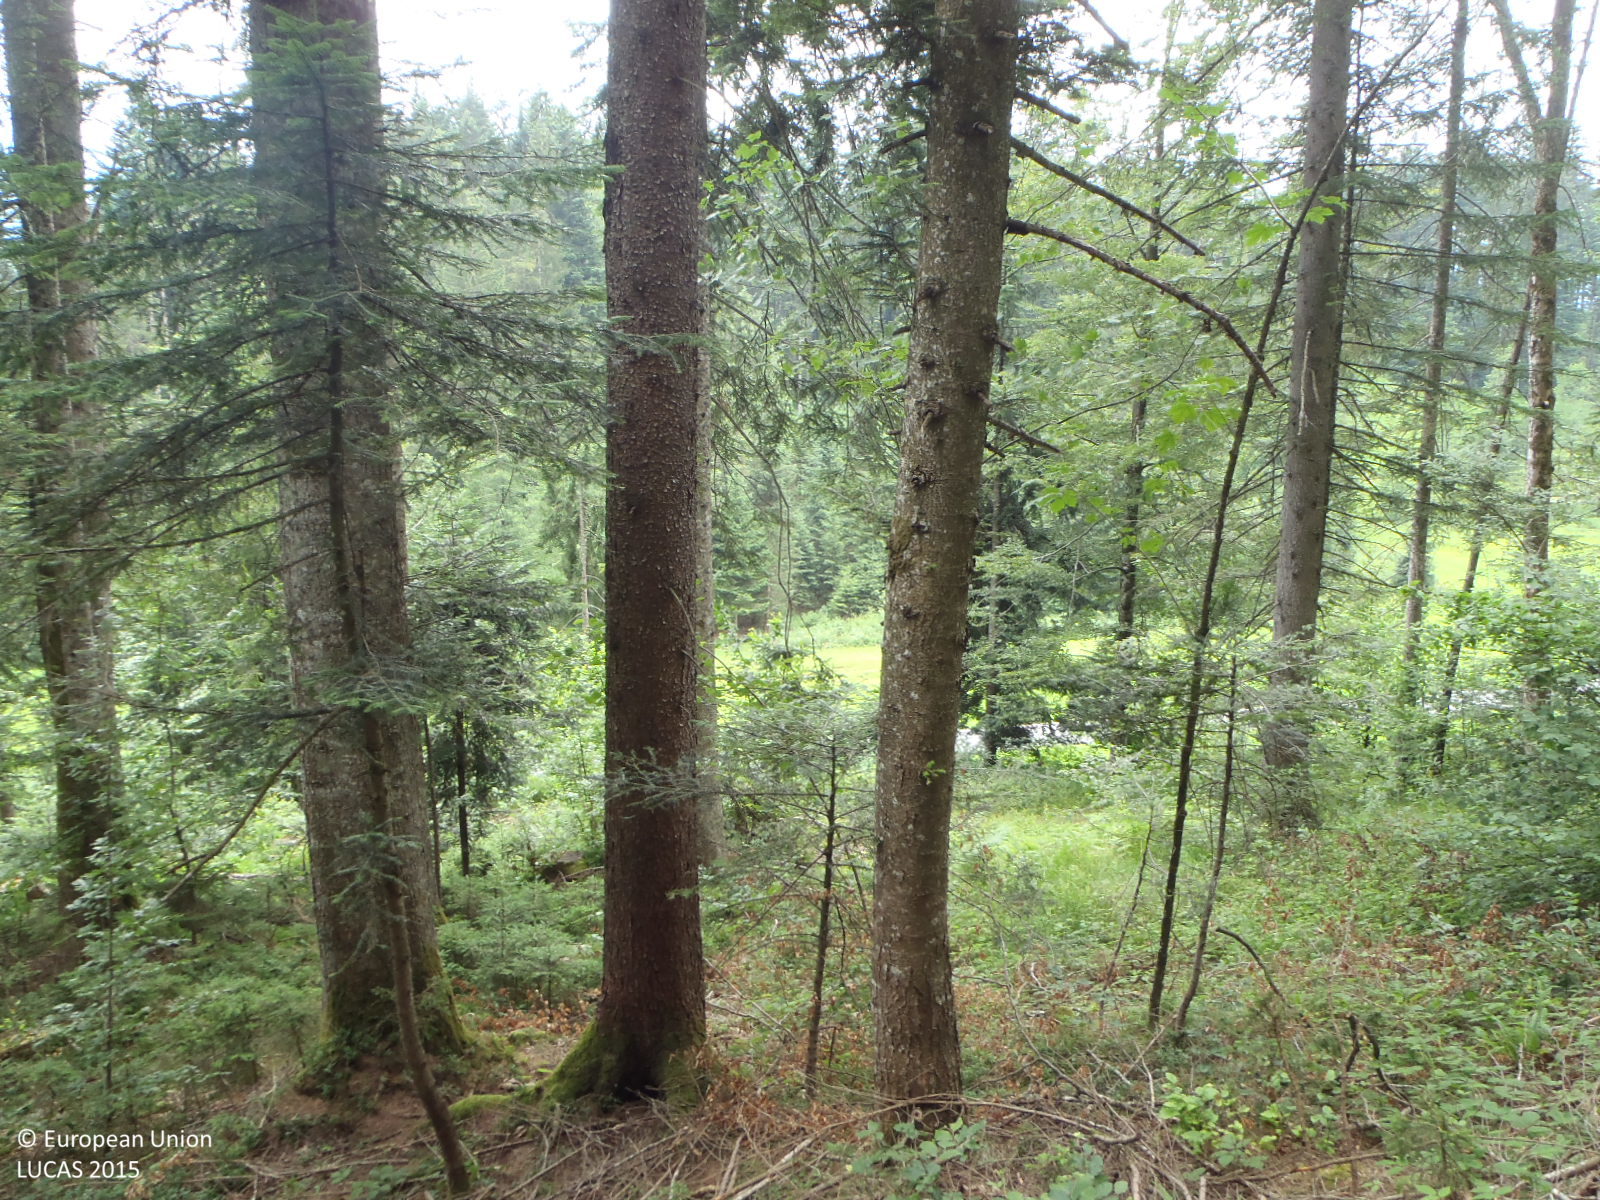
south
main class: Woodland
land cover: Other mixed woodland
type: alpine coniferous forest
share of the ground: > 75 %
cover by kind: coniferous forest trees 50 %, broadleaved forest trees 30 %, herbaceous plants 10 %, shrubs 5 %, lichens and mosses 5 %
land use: Forestry
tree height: > 5 m
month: July
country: AT
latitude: 47.5318
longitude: 12.3761
